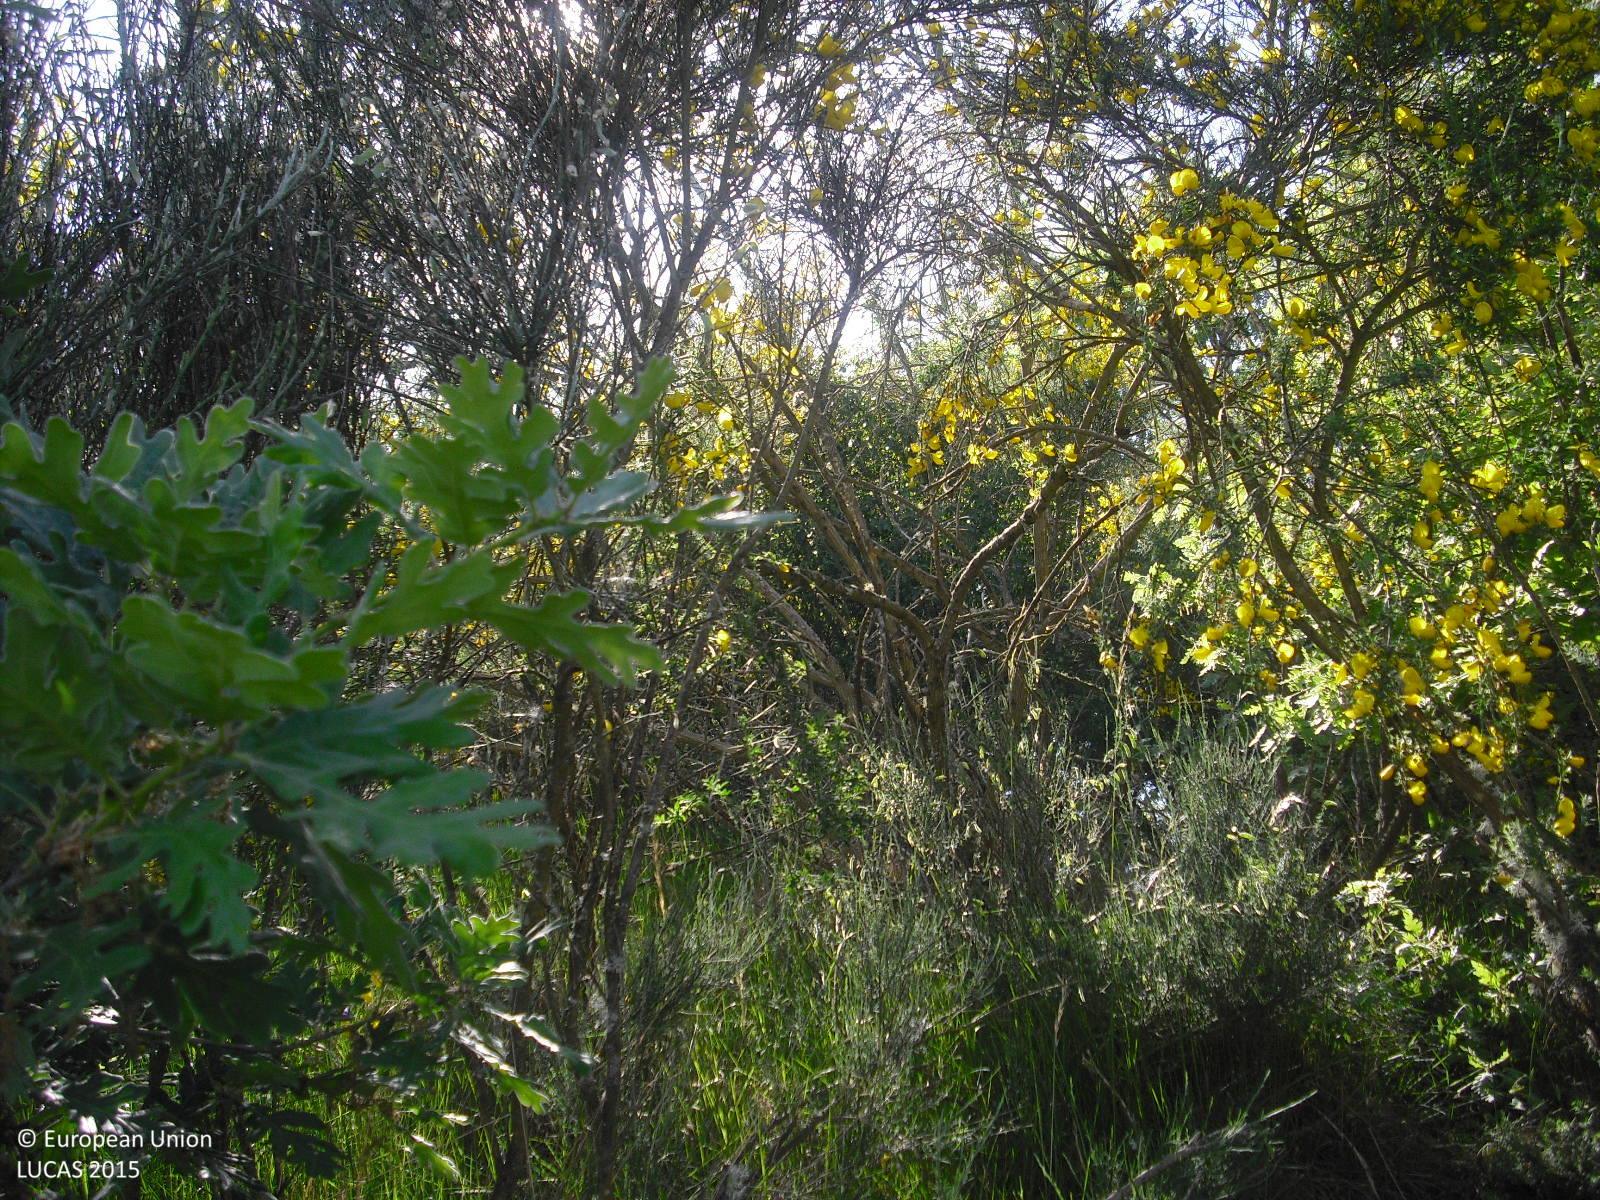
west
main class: Woodland
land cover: Broadleaved woodland
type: acidophilous oak and oak-birch forest
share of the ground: 25 - 50 %
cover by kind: shrubs 50 %, broadleaved forest trees 40 %, herbaceous plants 10 %
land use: Semi-natural and natural areas not in use
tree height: < 5 m
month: May
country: ES
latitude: 42.1240
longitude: -7.7435
